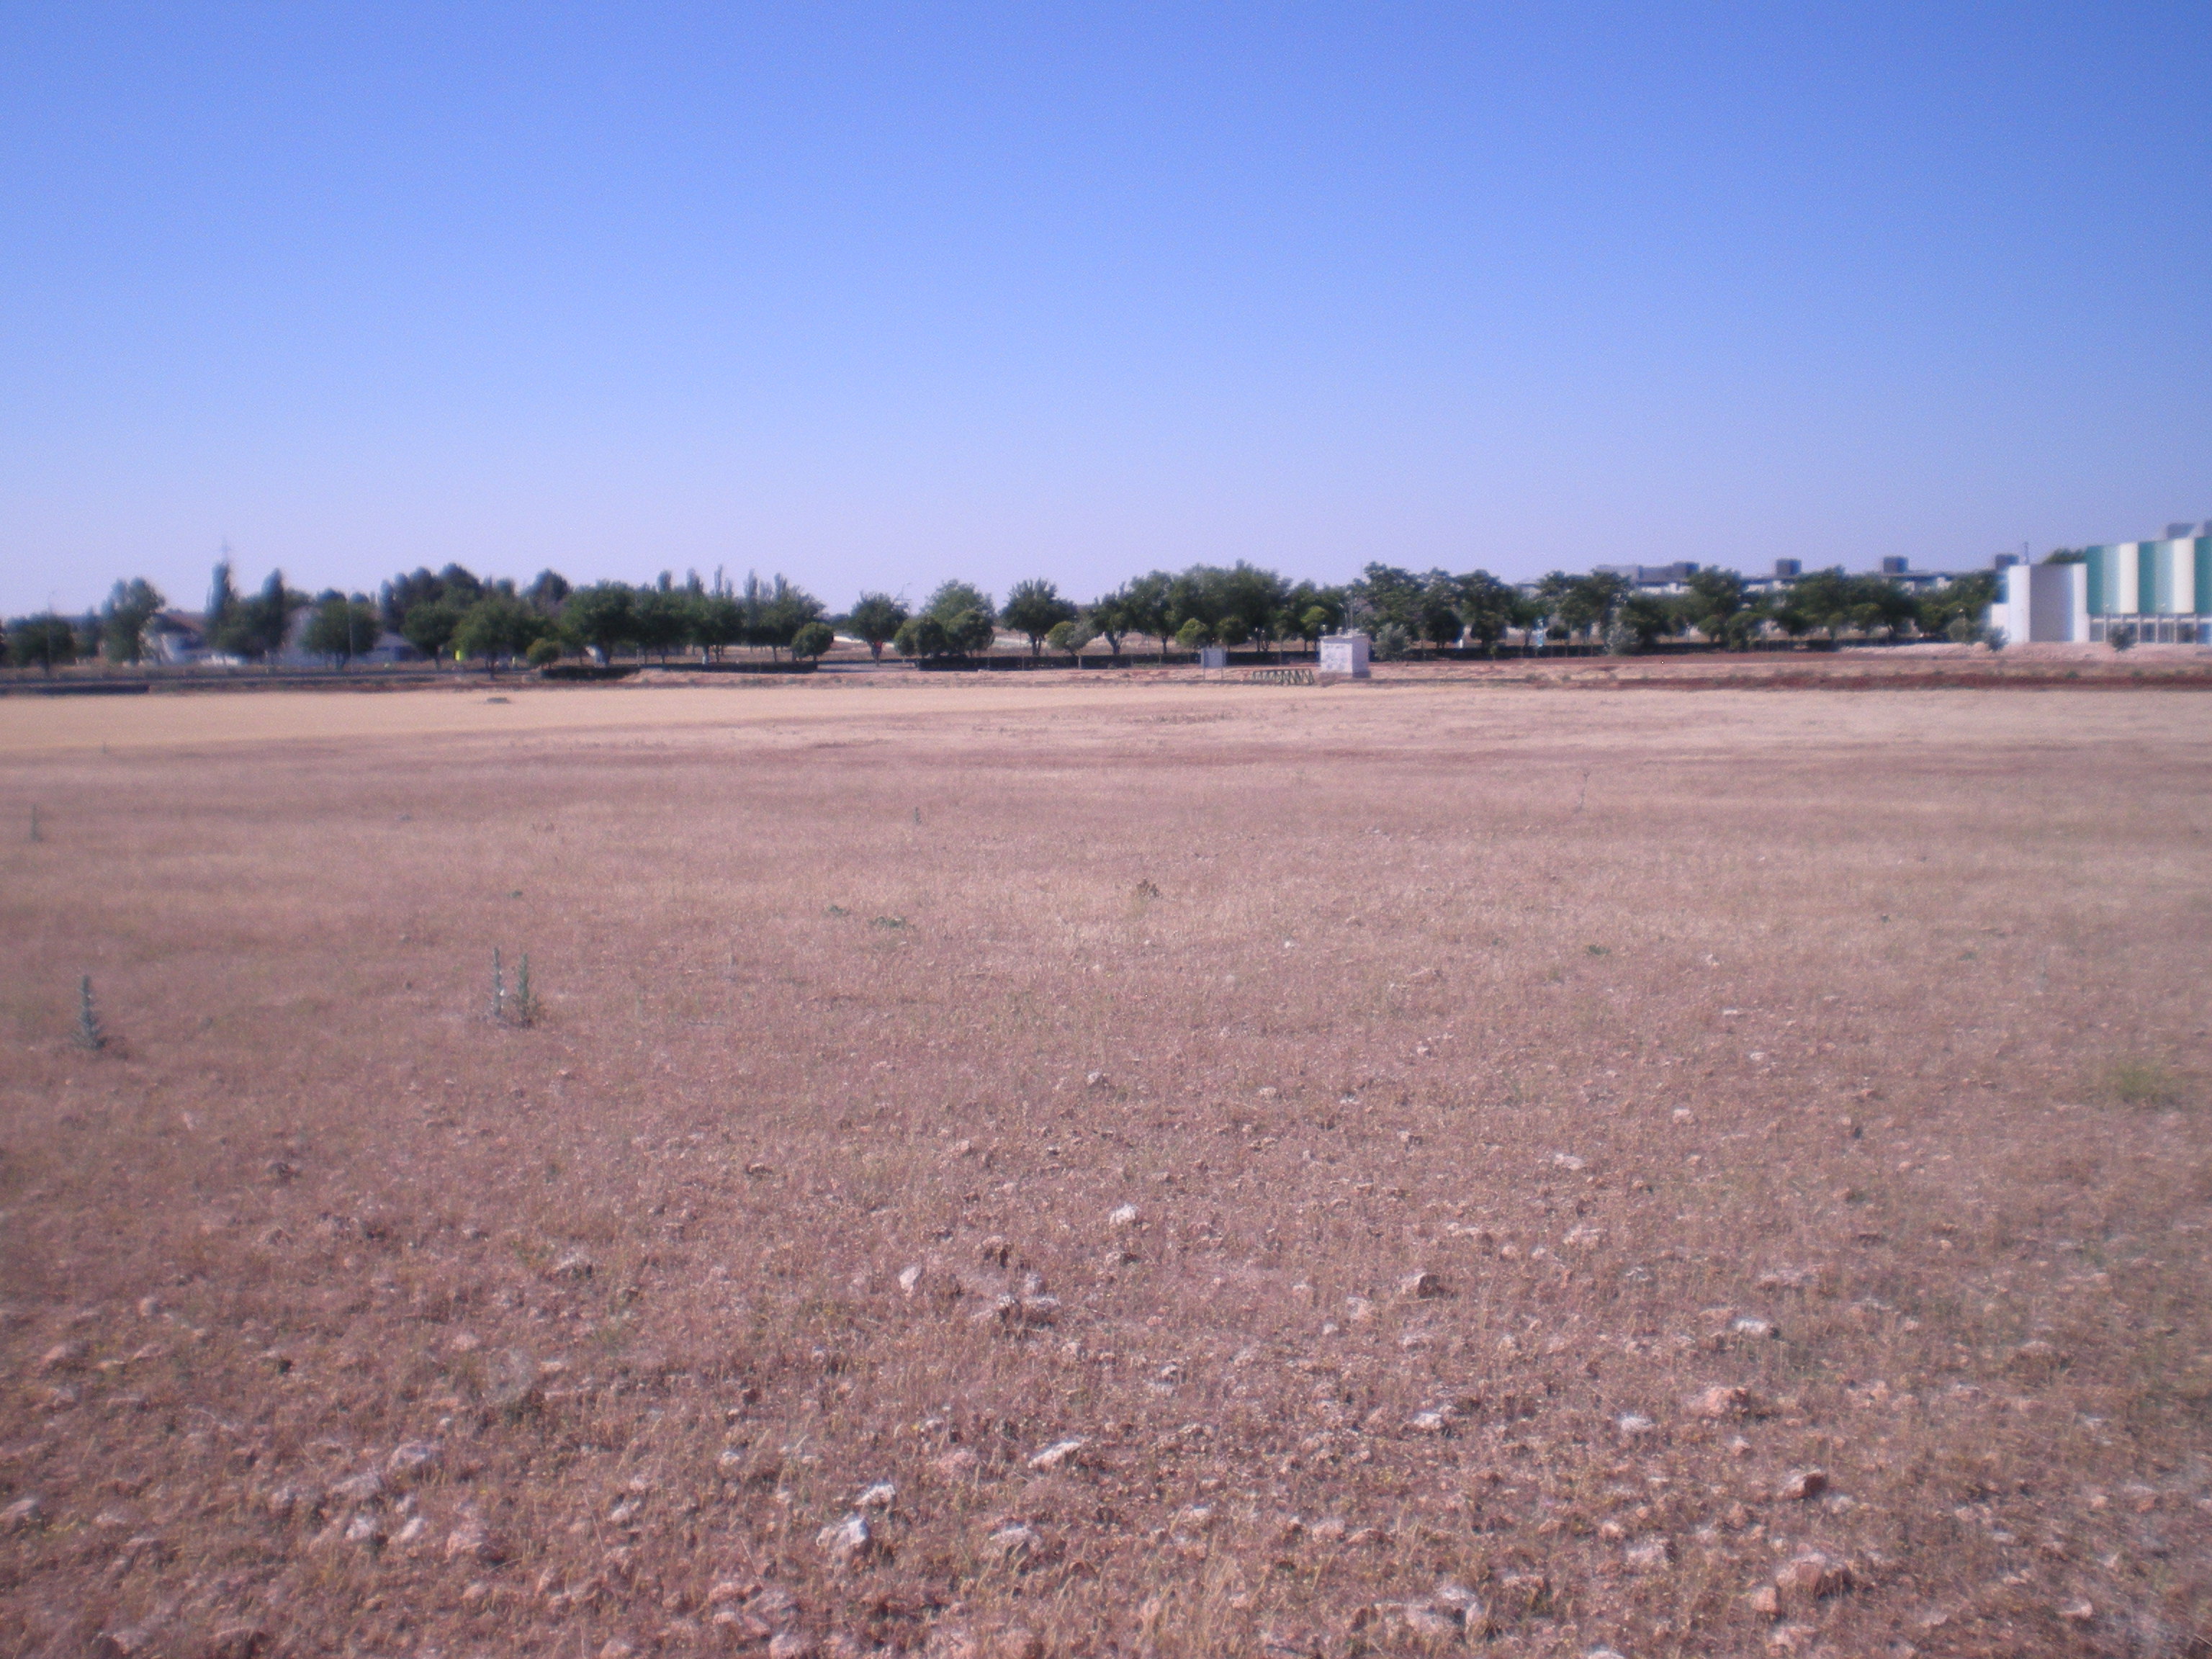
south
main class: Grassland
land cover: Spontaneously vegetated surfaces
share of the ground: 10 - 25 %
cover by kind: unconsolidated bare surface 90 %, herbaceous plants 10 %
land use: Agriculture (excluding fallow land and kitchen gardens)
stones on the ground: 10 - 25 %
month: May
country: ES
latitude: 39.0772
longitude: -3.6000
